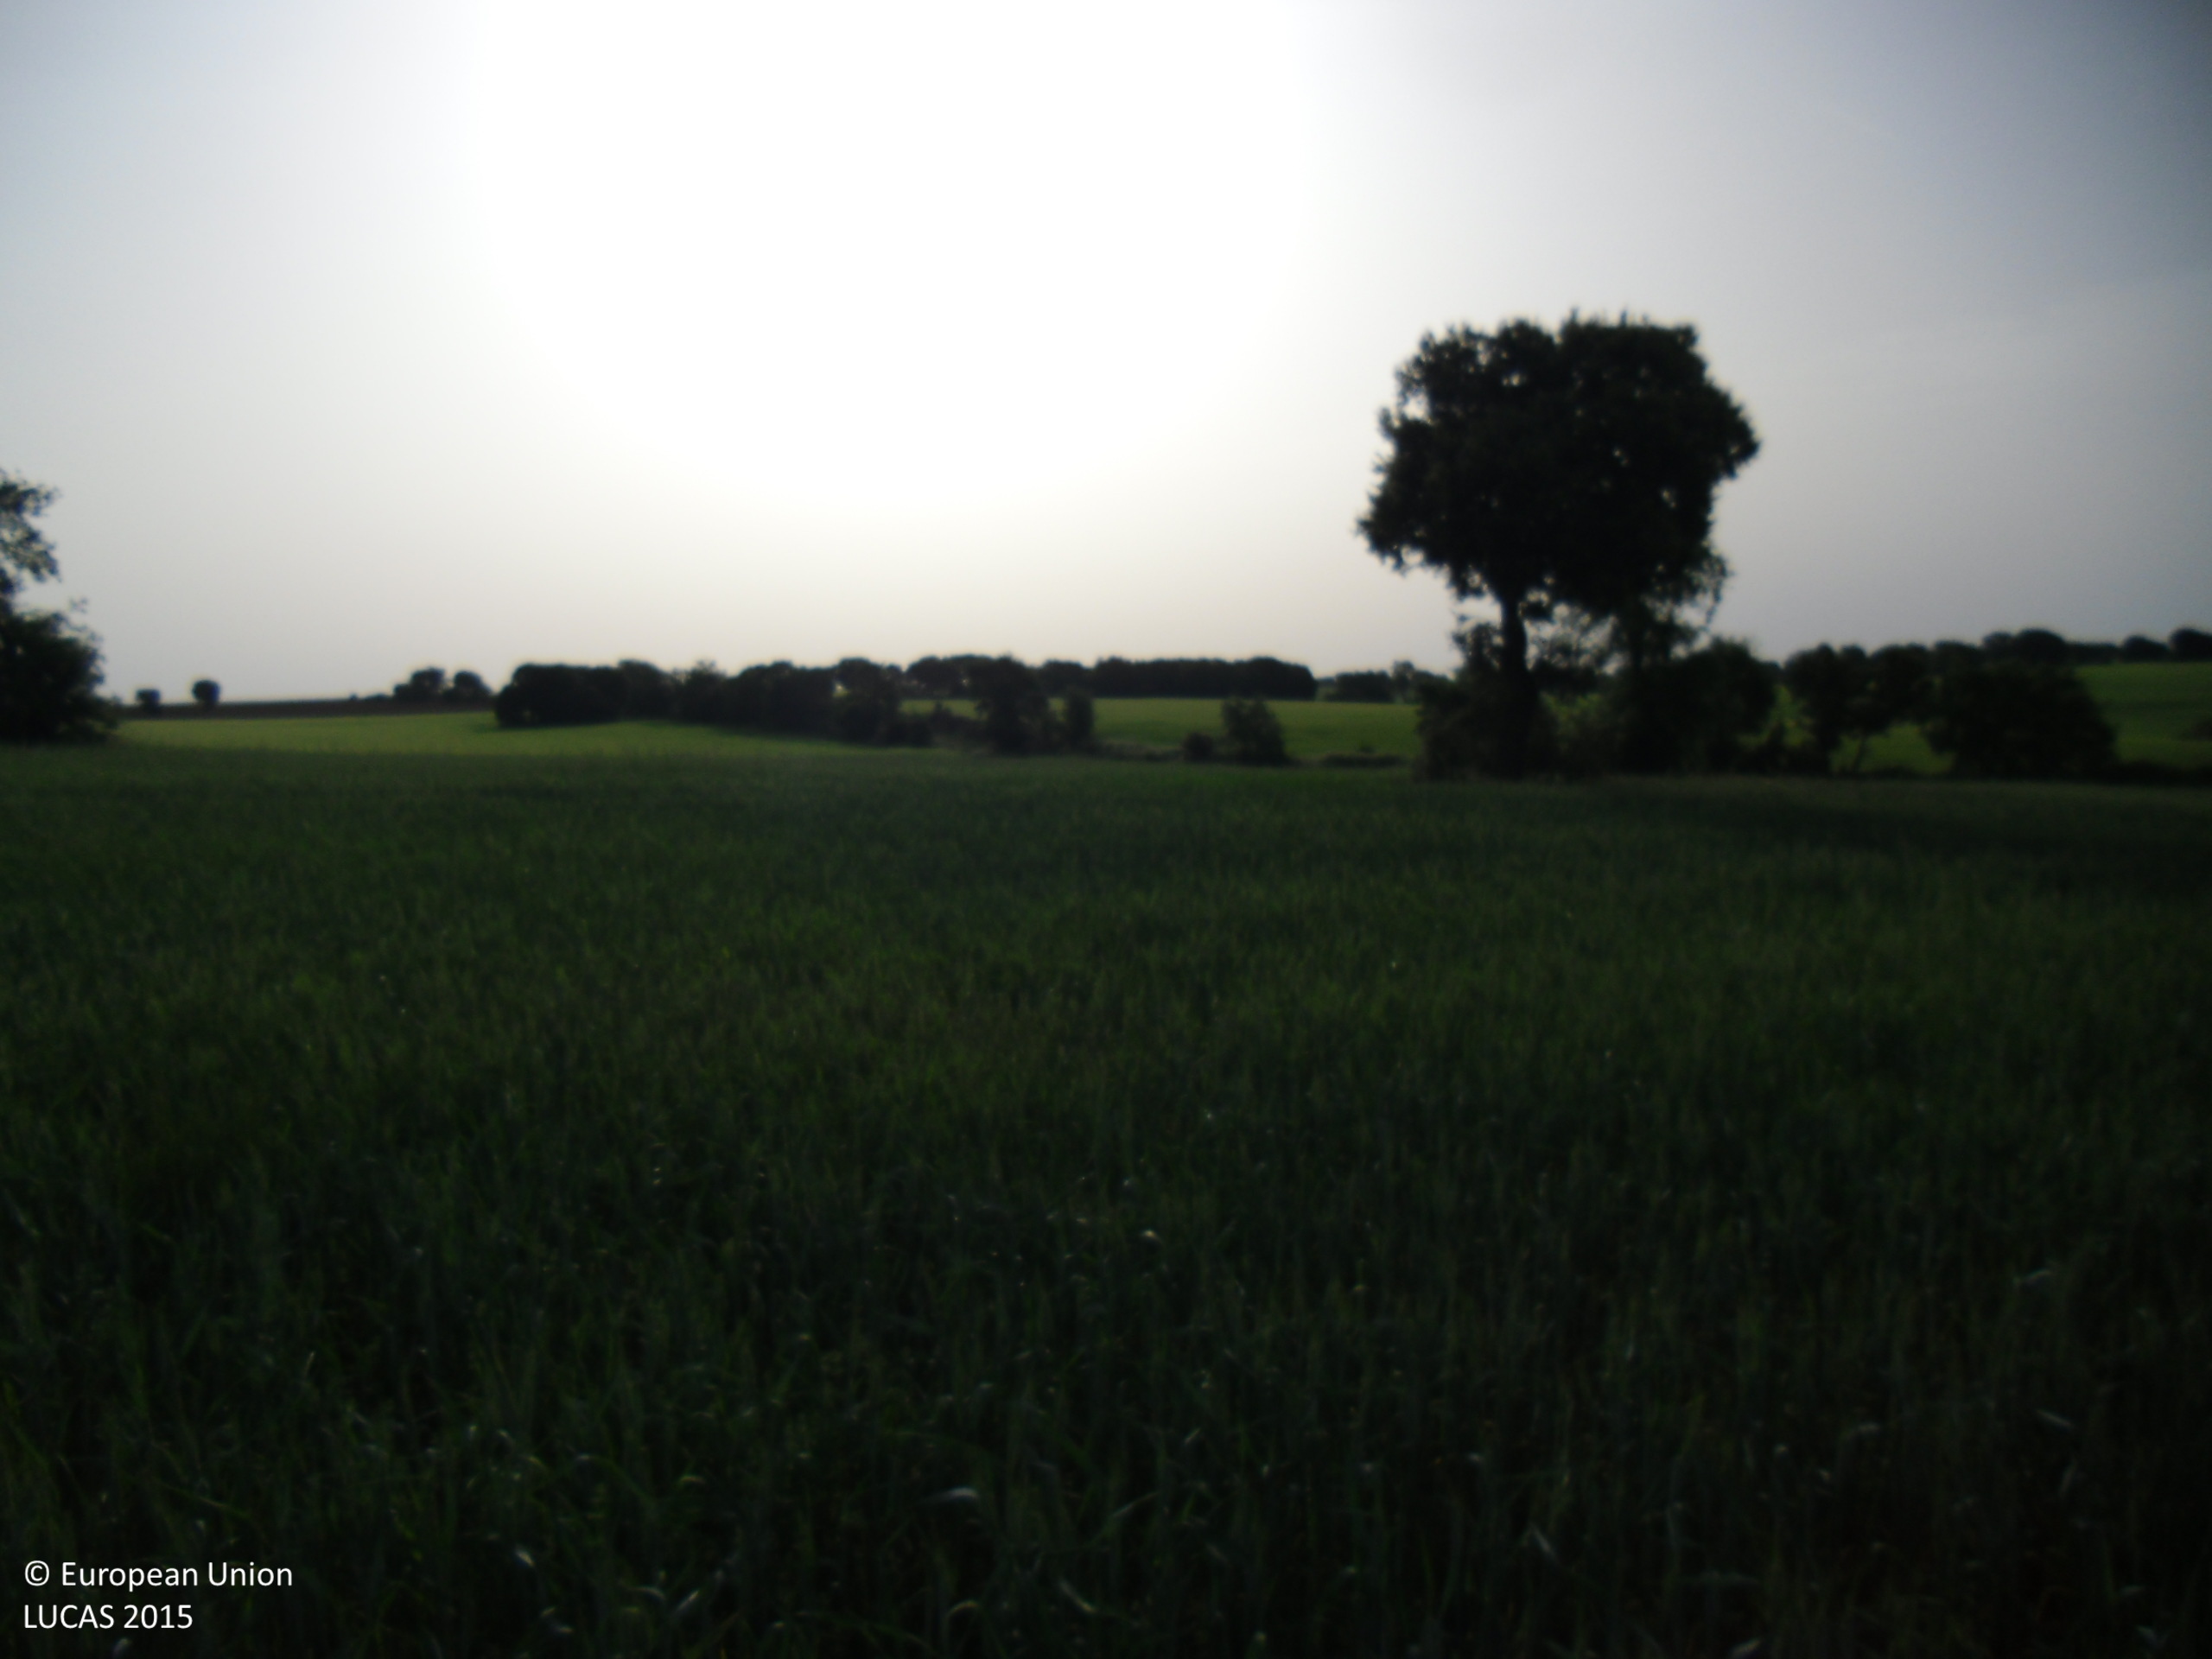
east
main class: Cropland
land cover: Common wheat
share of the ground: > 75 %
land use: Agriculture (excluding fallow land and kitchen gardens)
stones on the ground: < 10 %
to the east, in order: Common wheat; Grass margins; Tracks; Shruby margins; Barley
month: May
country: ES
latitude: 40.5089
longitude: -2.9041
